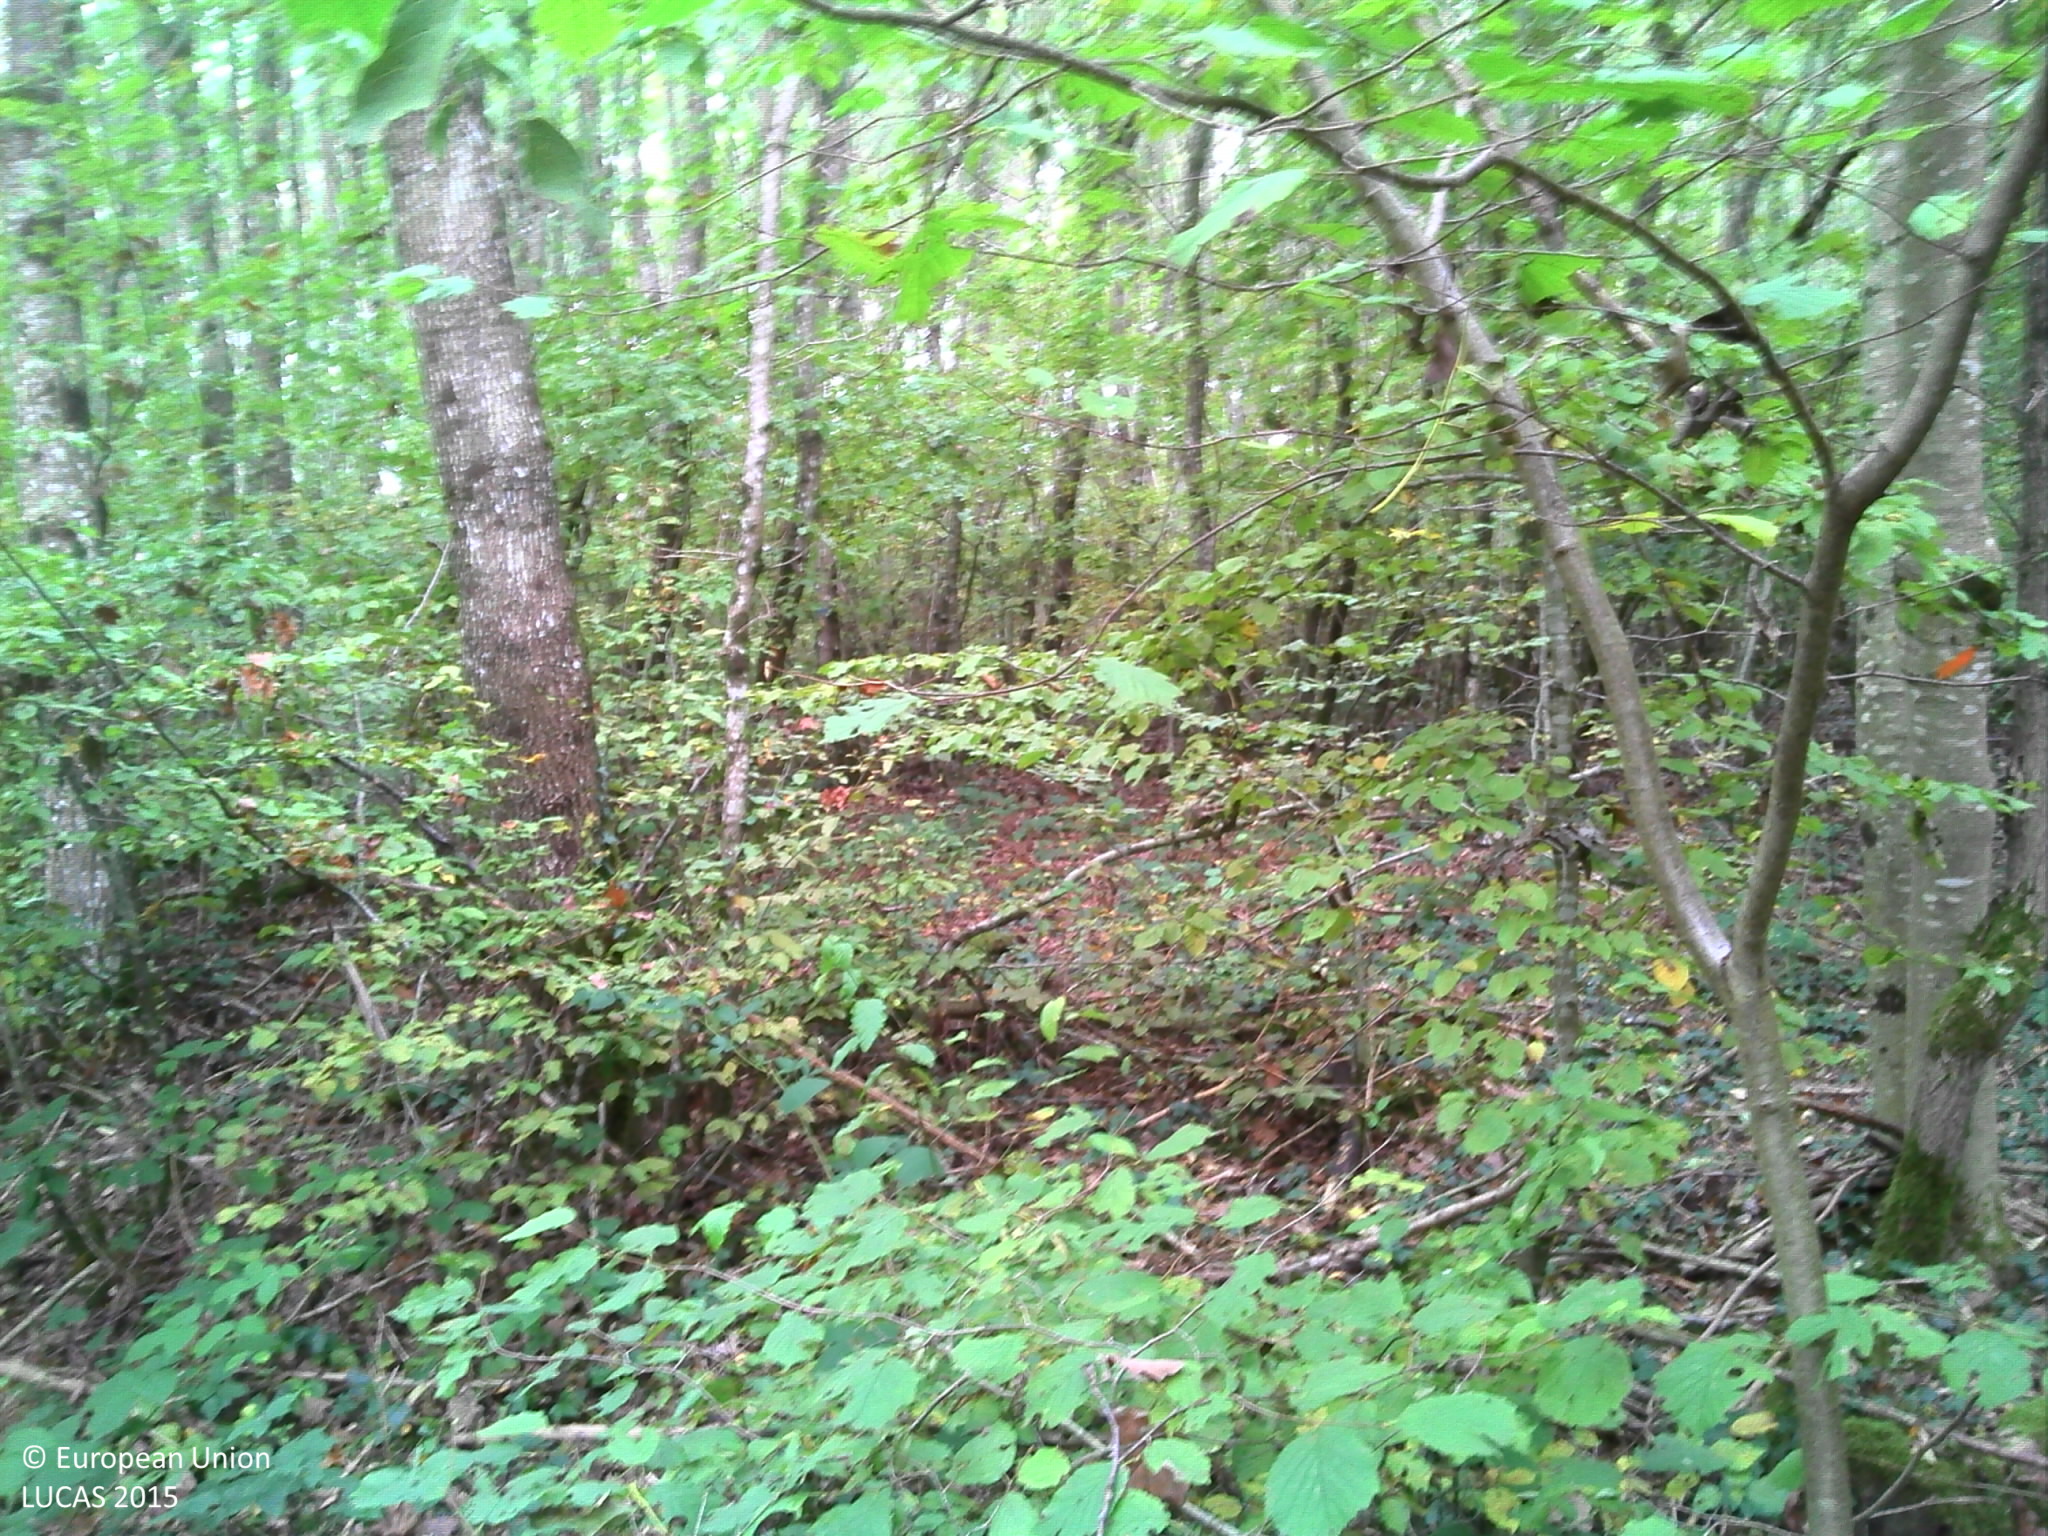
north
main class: Woodland
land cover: Broadleaved woodland
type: mesophytic deciduous forest
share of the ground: > 75 %
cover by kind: broadleaved forest trees 100 %
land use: Forestry
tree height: > 5 m
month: October
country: FR
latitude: 47.5514
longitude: 5.4162
